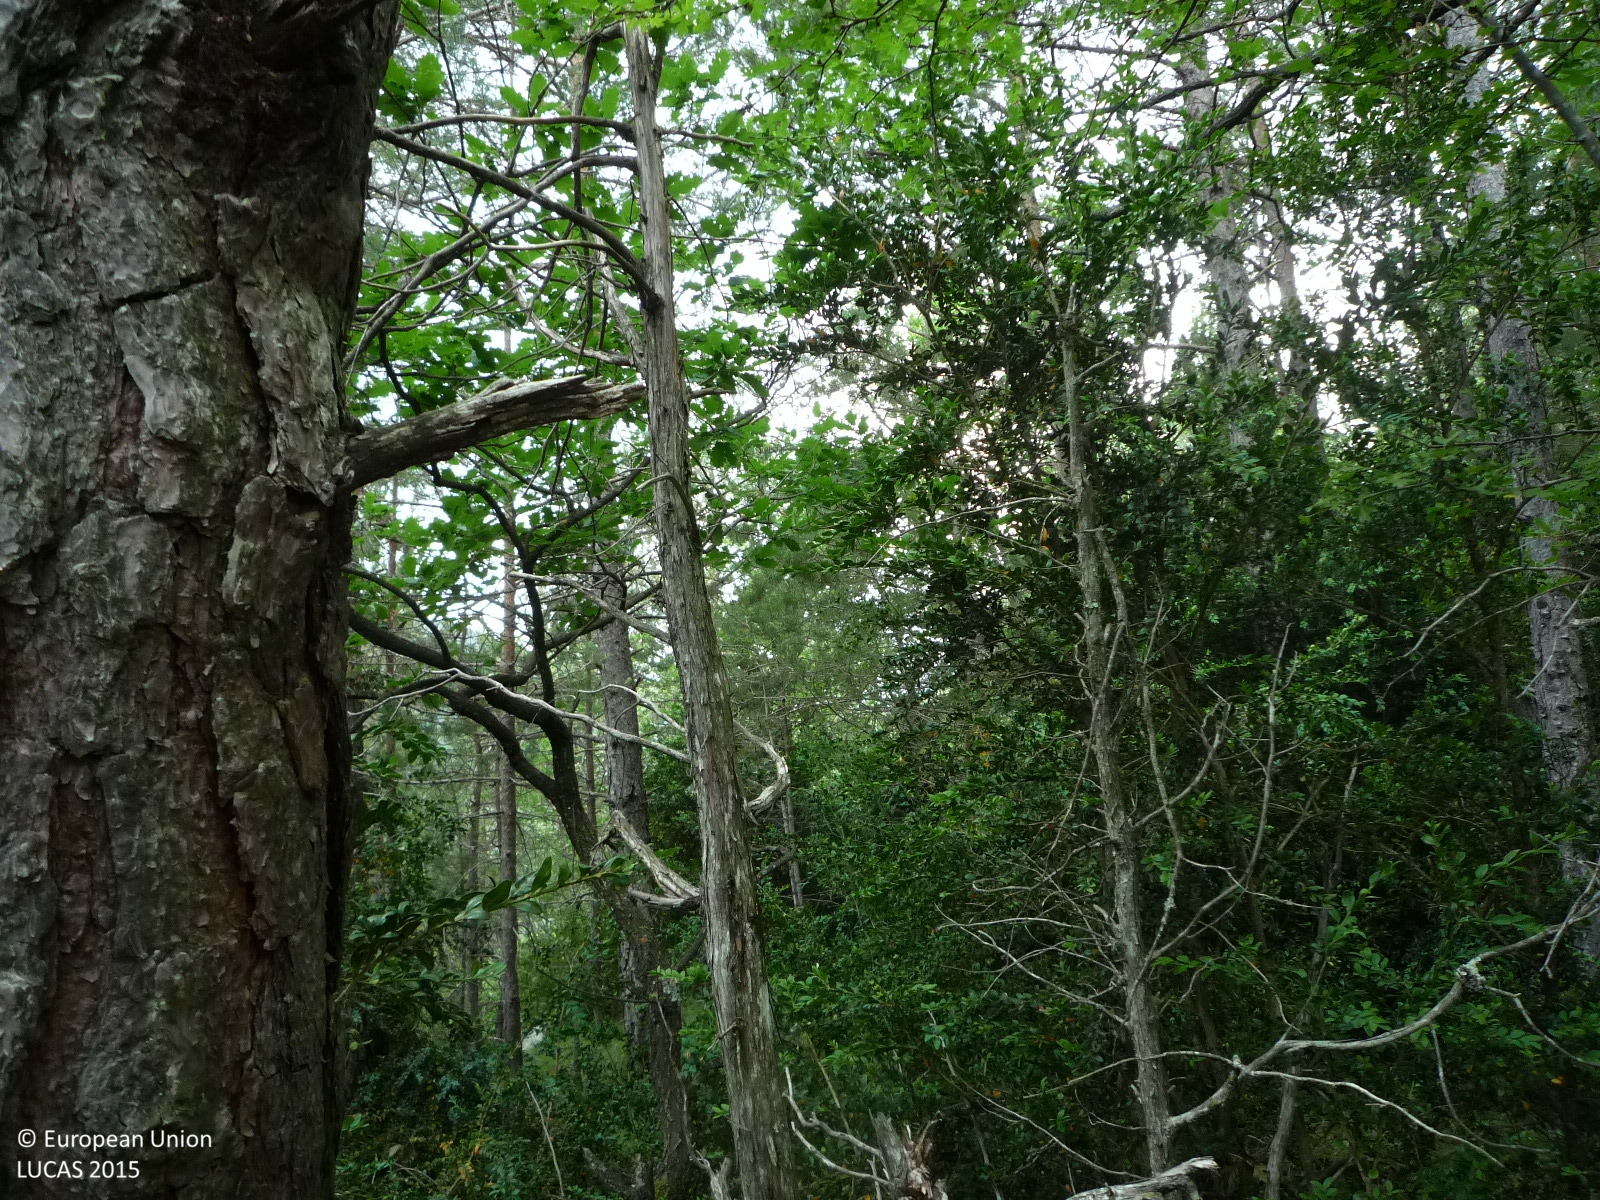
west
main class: Woodland
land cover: Pine dominated mixed woodland
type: alpine coniferous forest
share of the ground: > 75 %
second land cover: Shrubland without tree cover
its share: < 10 %
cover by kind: coniferous forest trees 60 %, broadleaved forest trees 30 %, shrubs 10 %
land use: Forestry
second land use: Agriculture (excluding fallow land and kitchen gardens)
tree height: > 5 m
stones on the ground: < 10 %
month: June
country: ES
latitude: 42.2626
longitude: 1.9749
